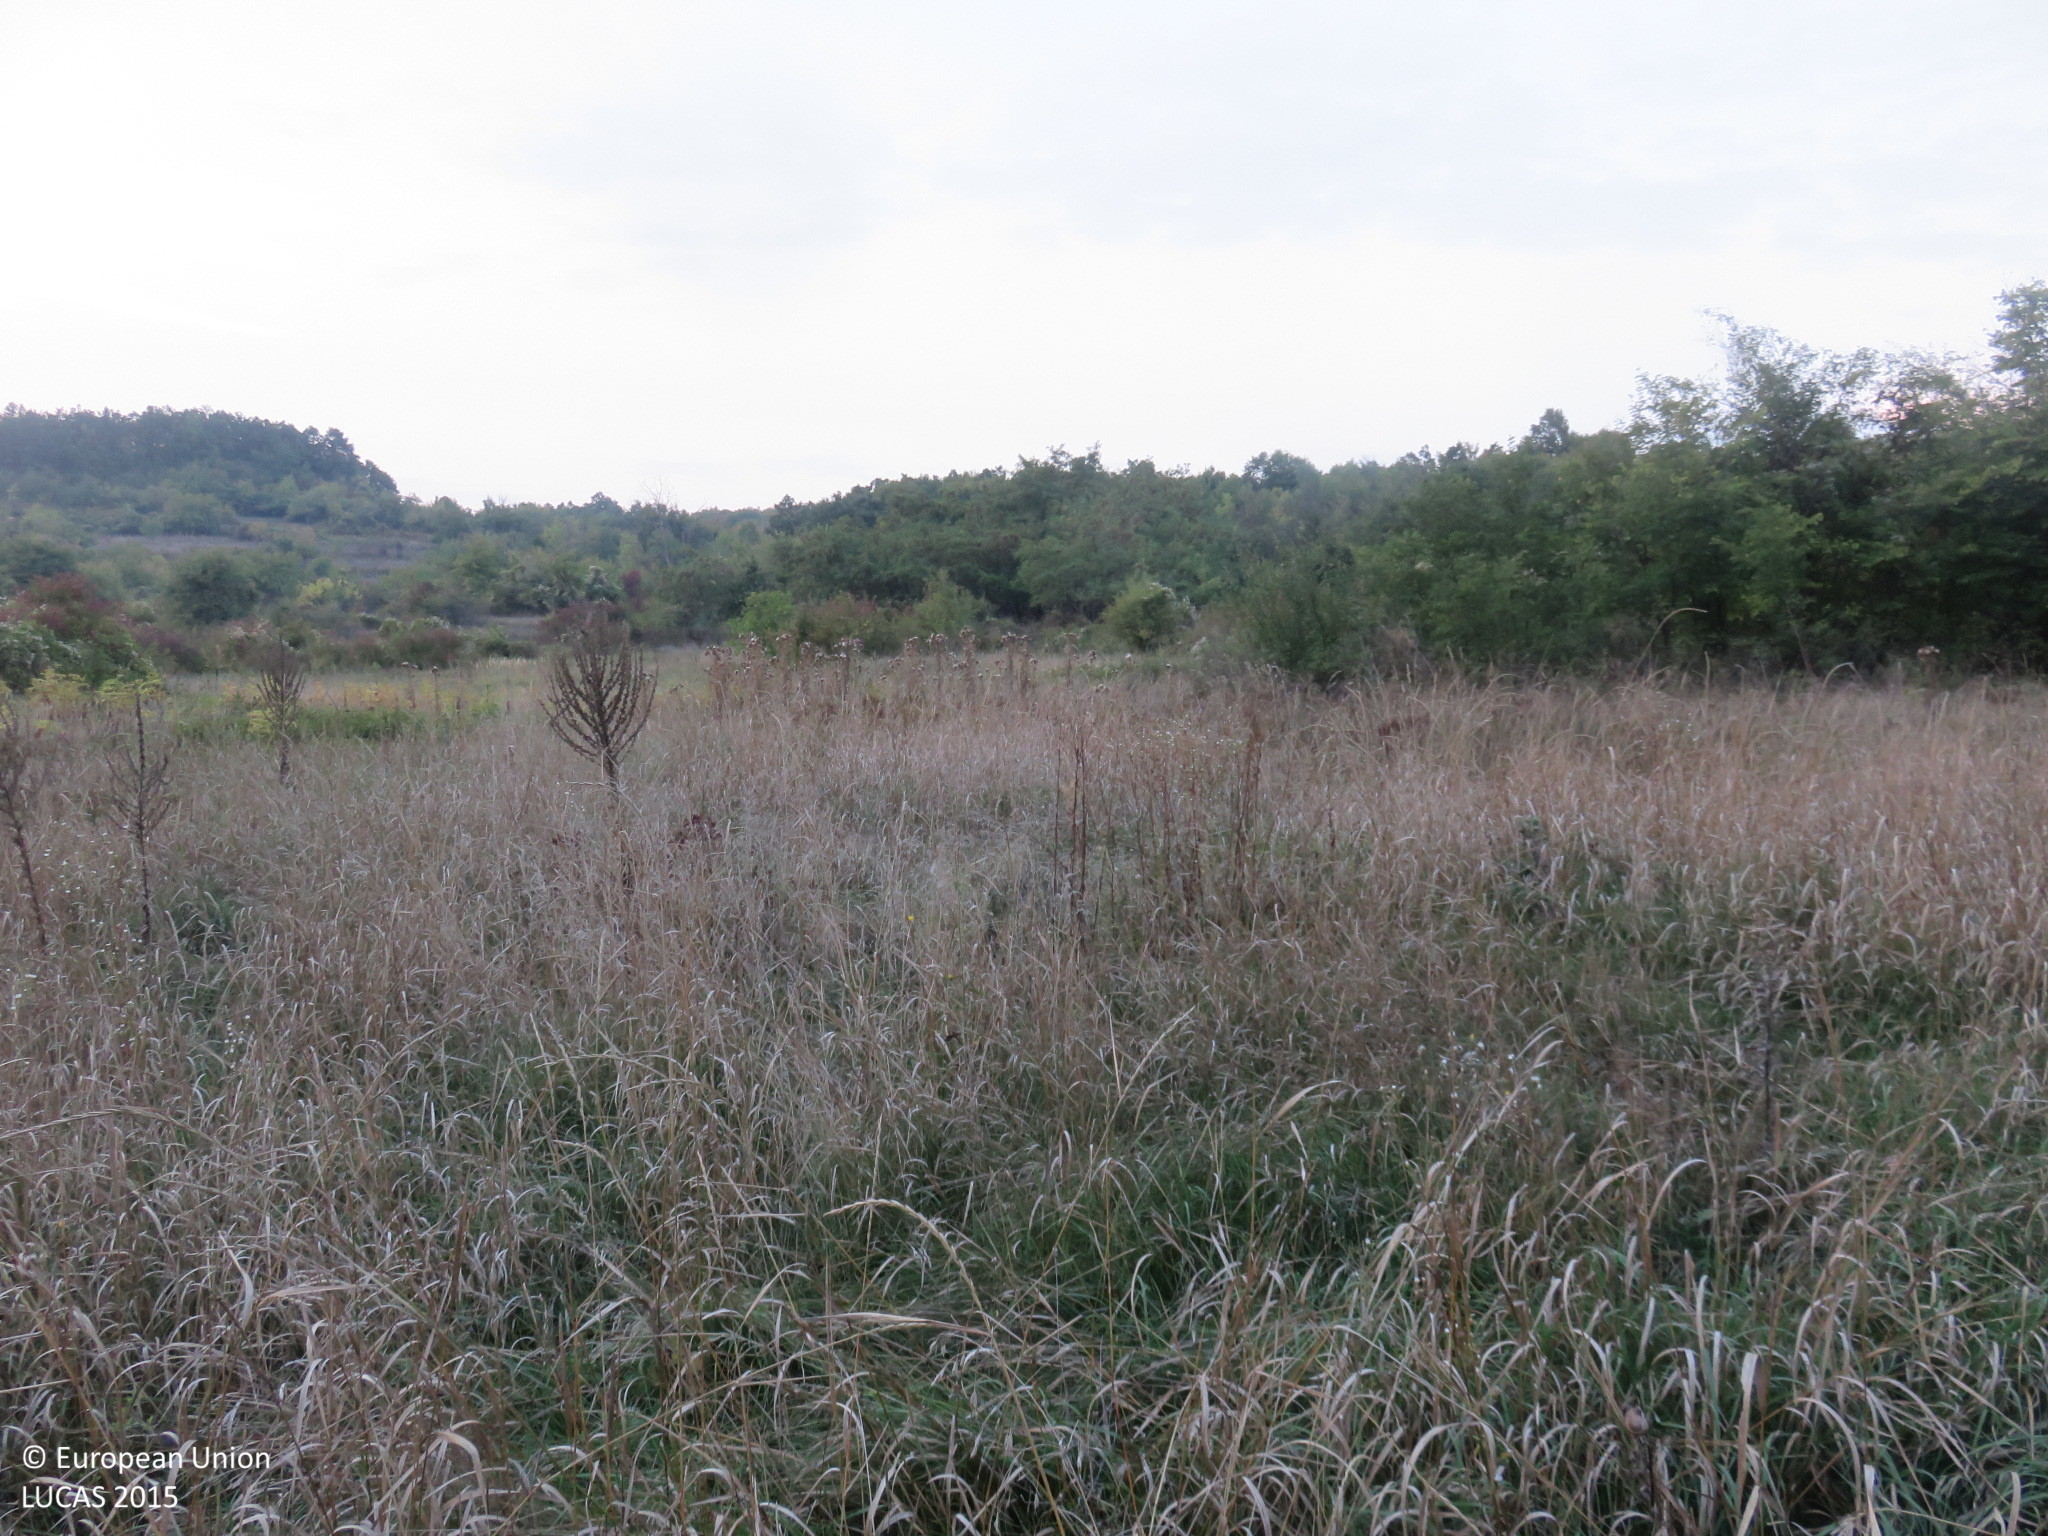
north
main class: Grassland
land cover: Grassland without tree/shrub cover
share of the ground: > 75 %
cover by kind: herbaceous plants 100 %
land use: Agriculture (excluding fallow land and kitchen gardens)
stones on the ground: < 10 %
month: September
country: BG
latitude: 43.1246
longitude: 24.8762
